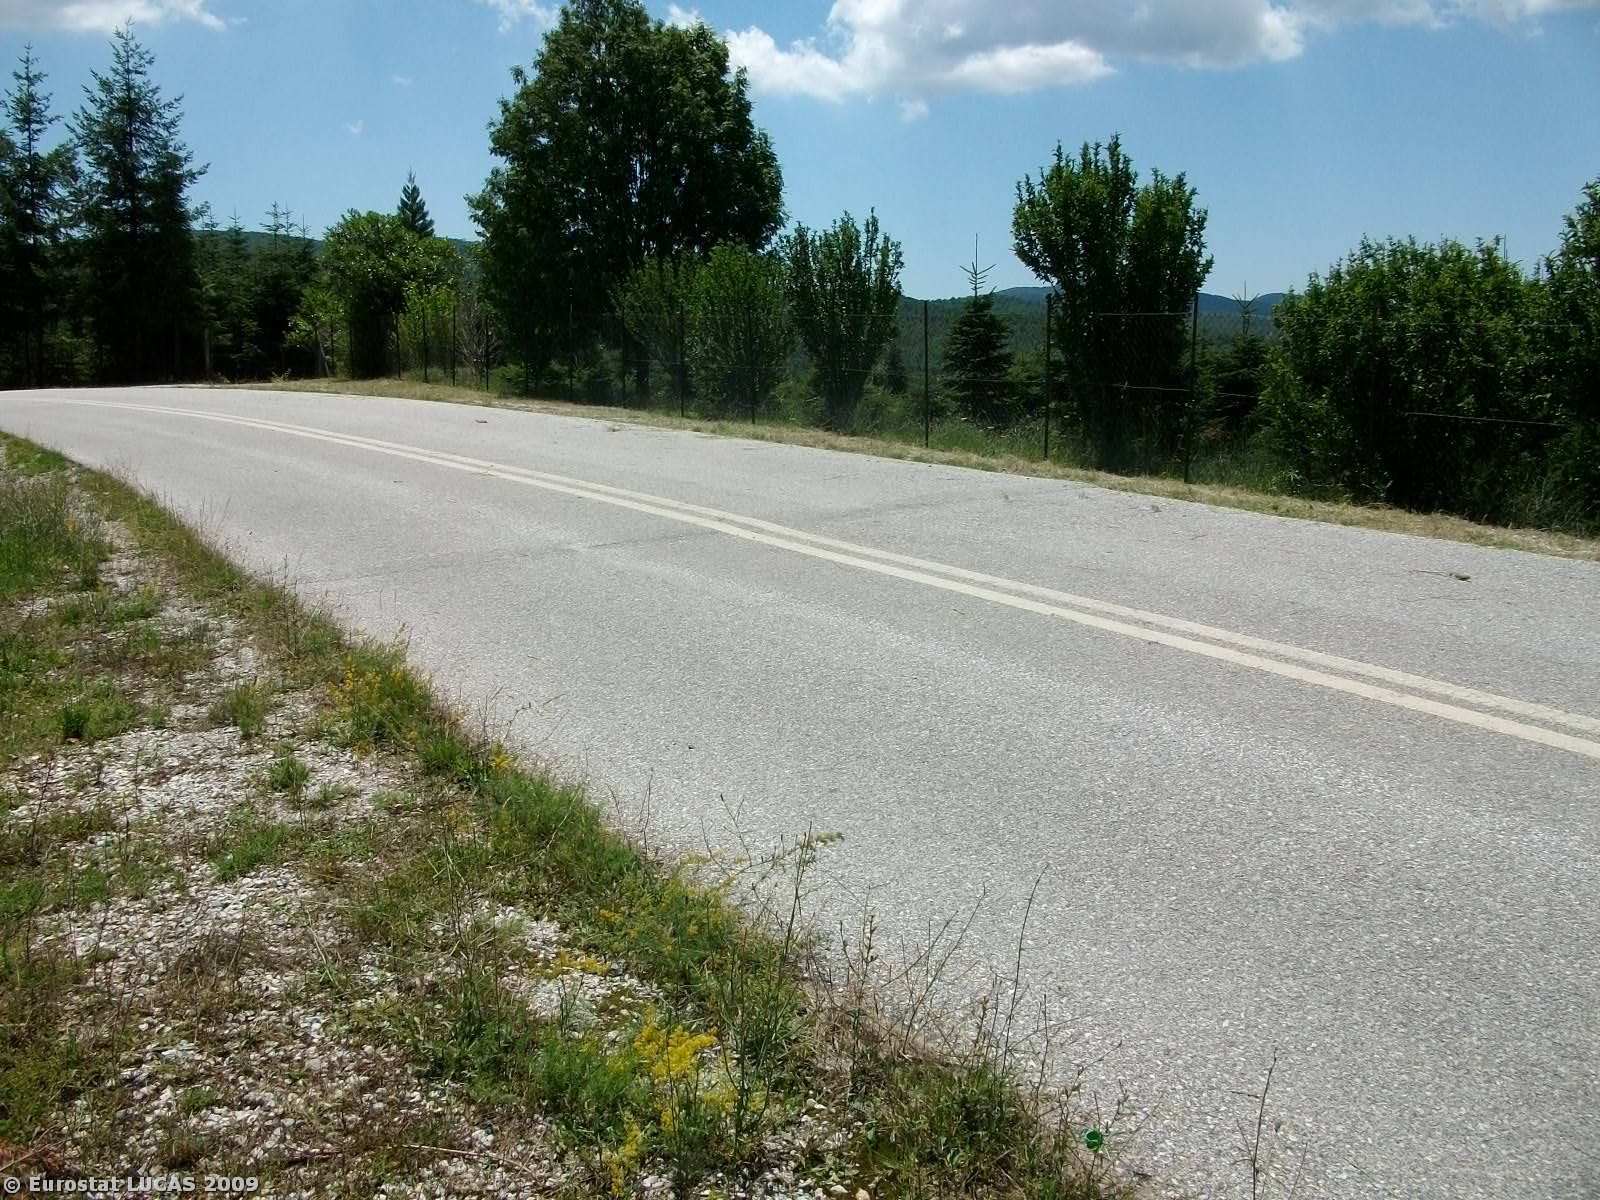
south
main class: Woodland
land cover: Coniferous woodland
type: coniferous forest of the mediterranean region
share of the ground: 50 - 75 %
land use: Forestry
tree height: > 5 m
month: July
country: GR
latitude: 40.4482
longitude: 23.4883
